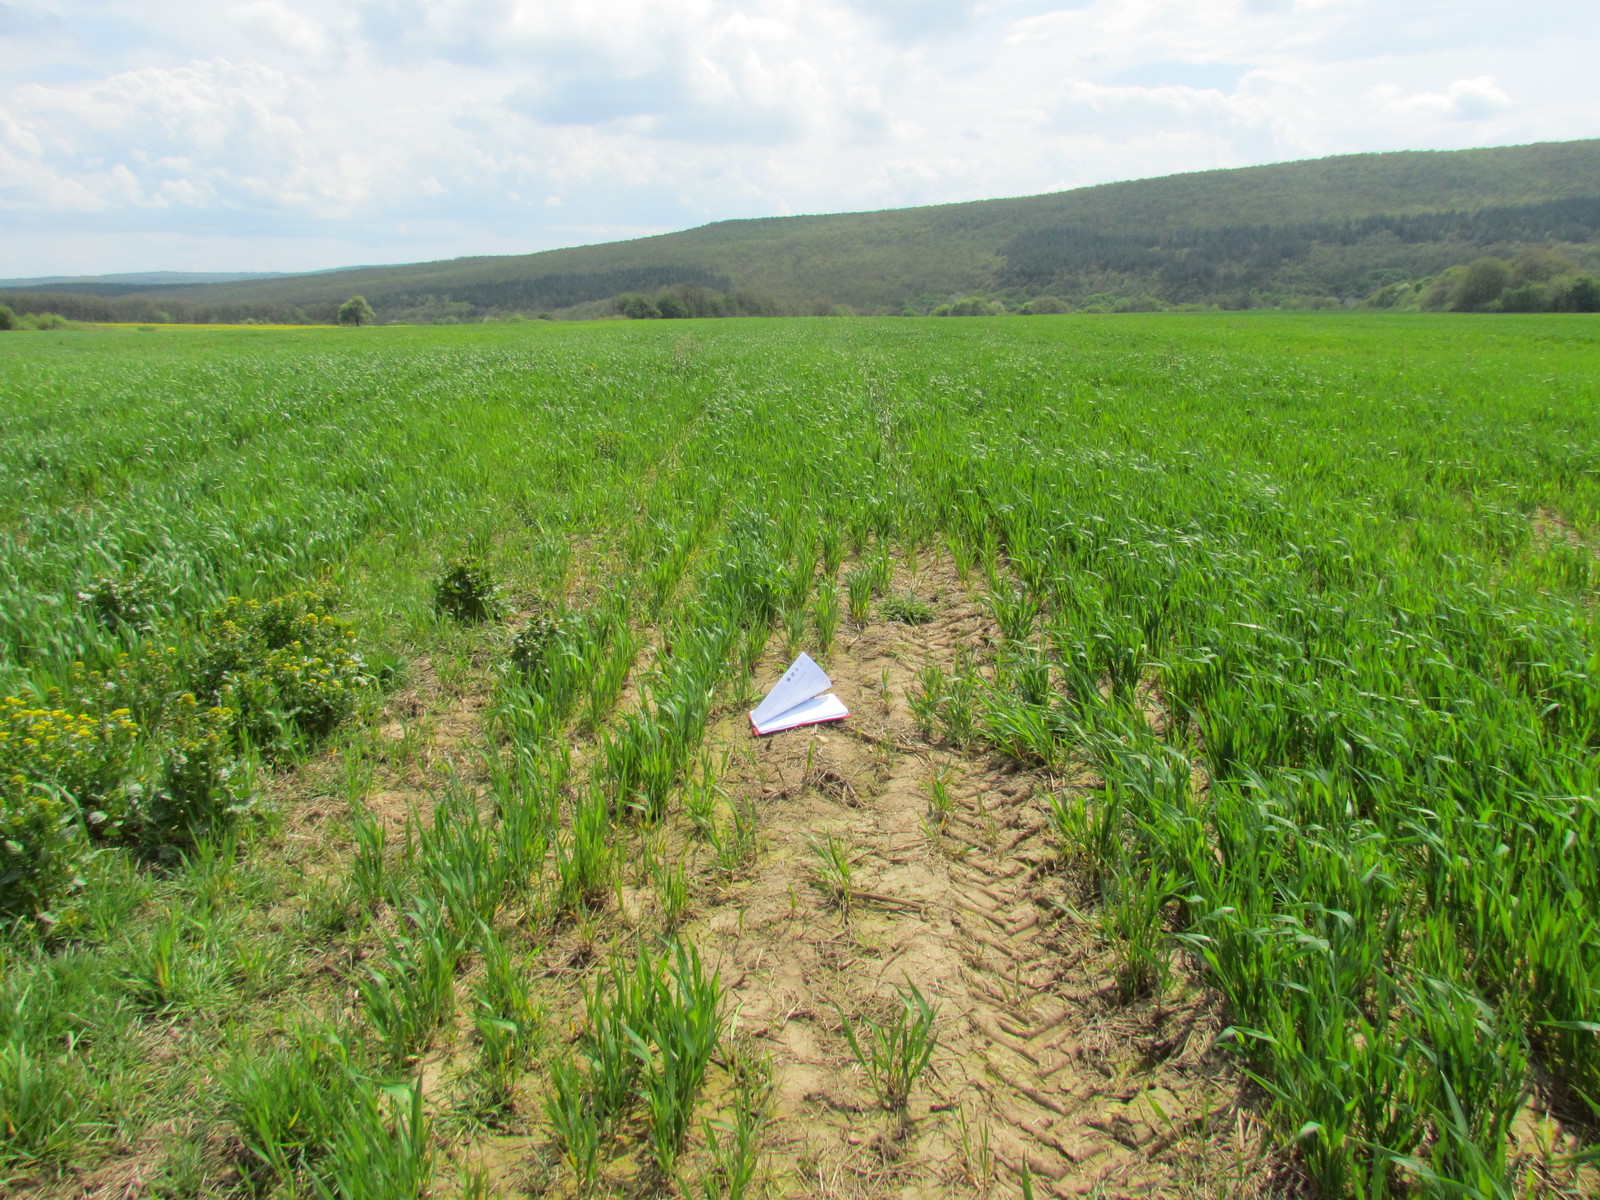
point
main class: Cropland
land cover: Barley
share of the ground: > 75 %
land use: Agriculture (excluding fallow land and kitchen gardens)
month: April
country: BG
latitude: 42.8457
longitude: 26.6560
